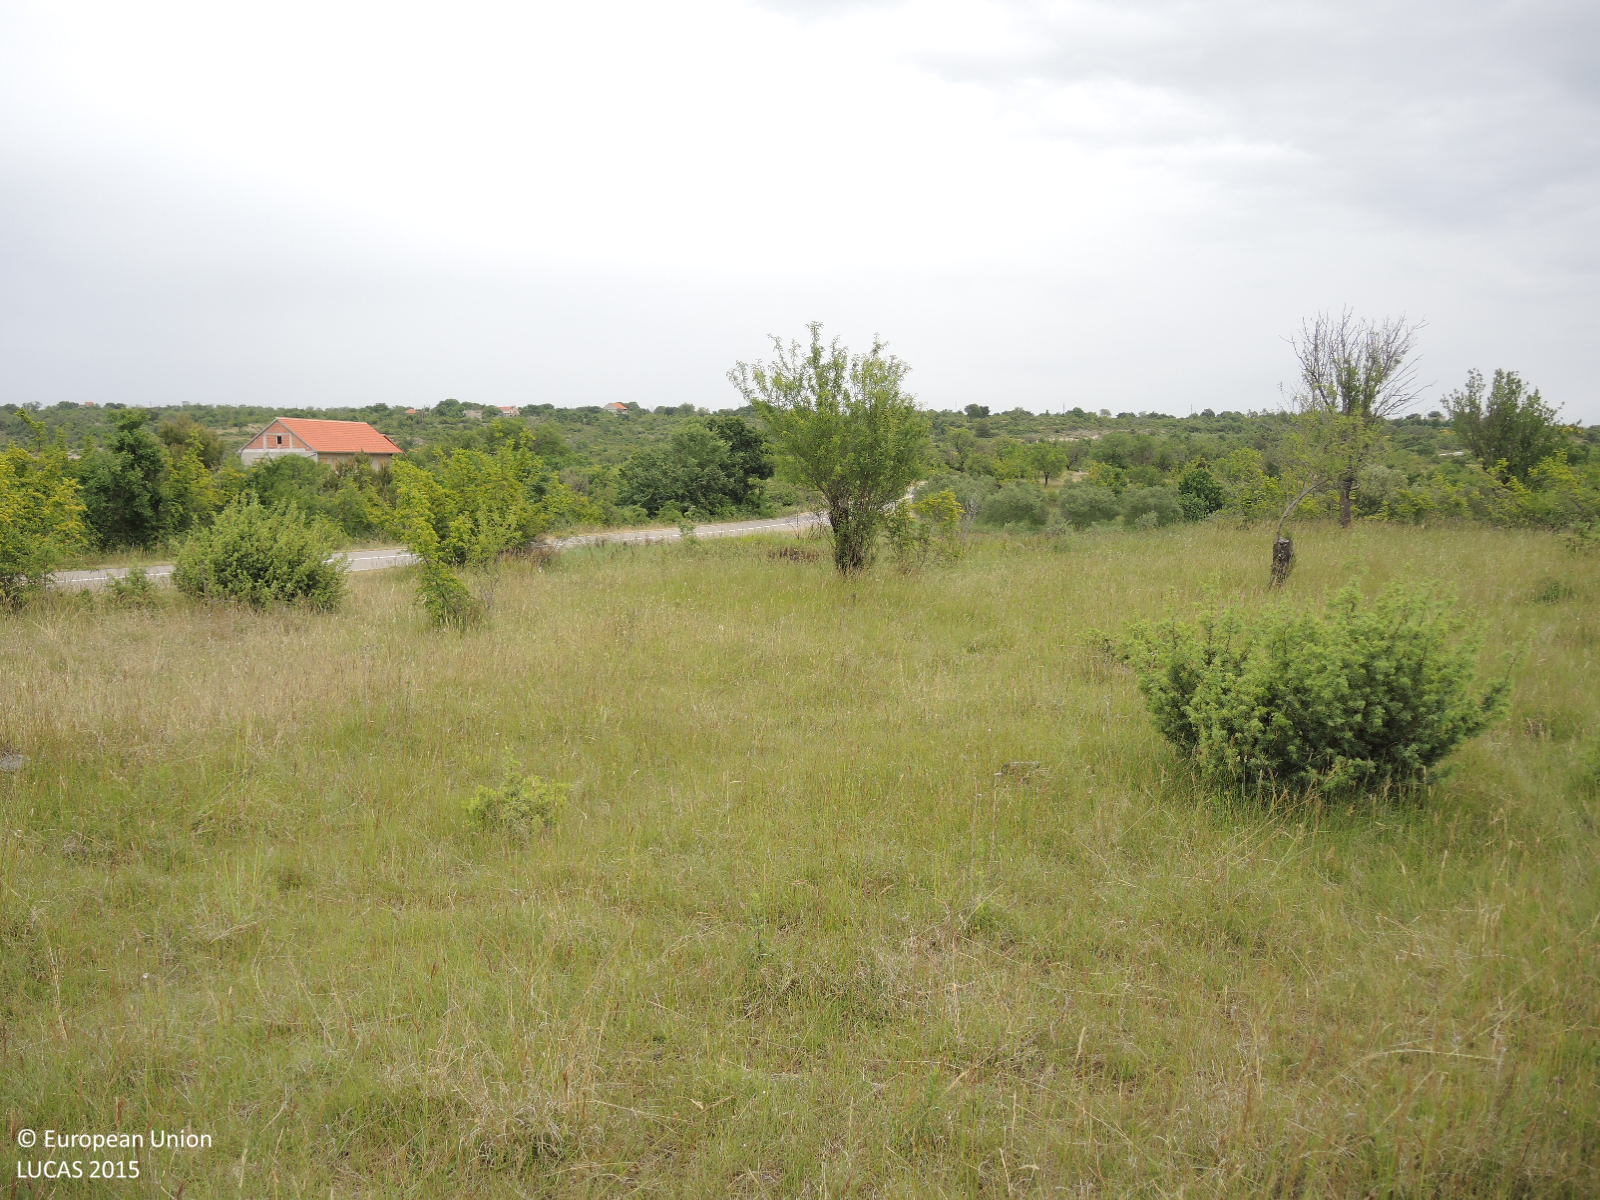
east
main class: Shrubland
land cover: Shrubland without tree cover
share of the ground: 10 - 25 %
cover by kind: herbaceous plants 65 %, shrubs 25 %, unconsolidated bare surface 10 %
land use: Semi-natural and natural areas not in use
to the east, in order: Shrubland without tree cover; Tracks; Shrubland without tree cover; Grass margins; Paved roads, cycling and walking lanes; Grass margins; Shrubland without tree cover; Shrubland with sparse tree cover; Grassland without tree/shrub cover; Tracks; Grassland without tree/shrub cover; Tracks; Shrubland without tree cover; Tracks; Olive groves
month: May
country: HR
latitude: 43.9153
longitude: 15.8322
